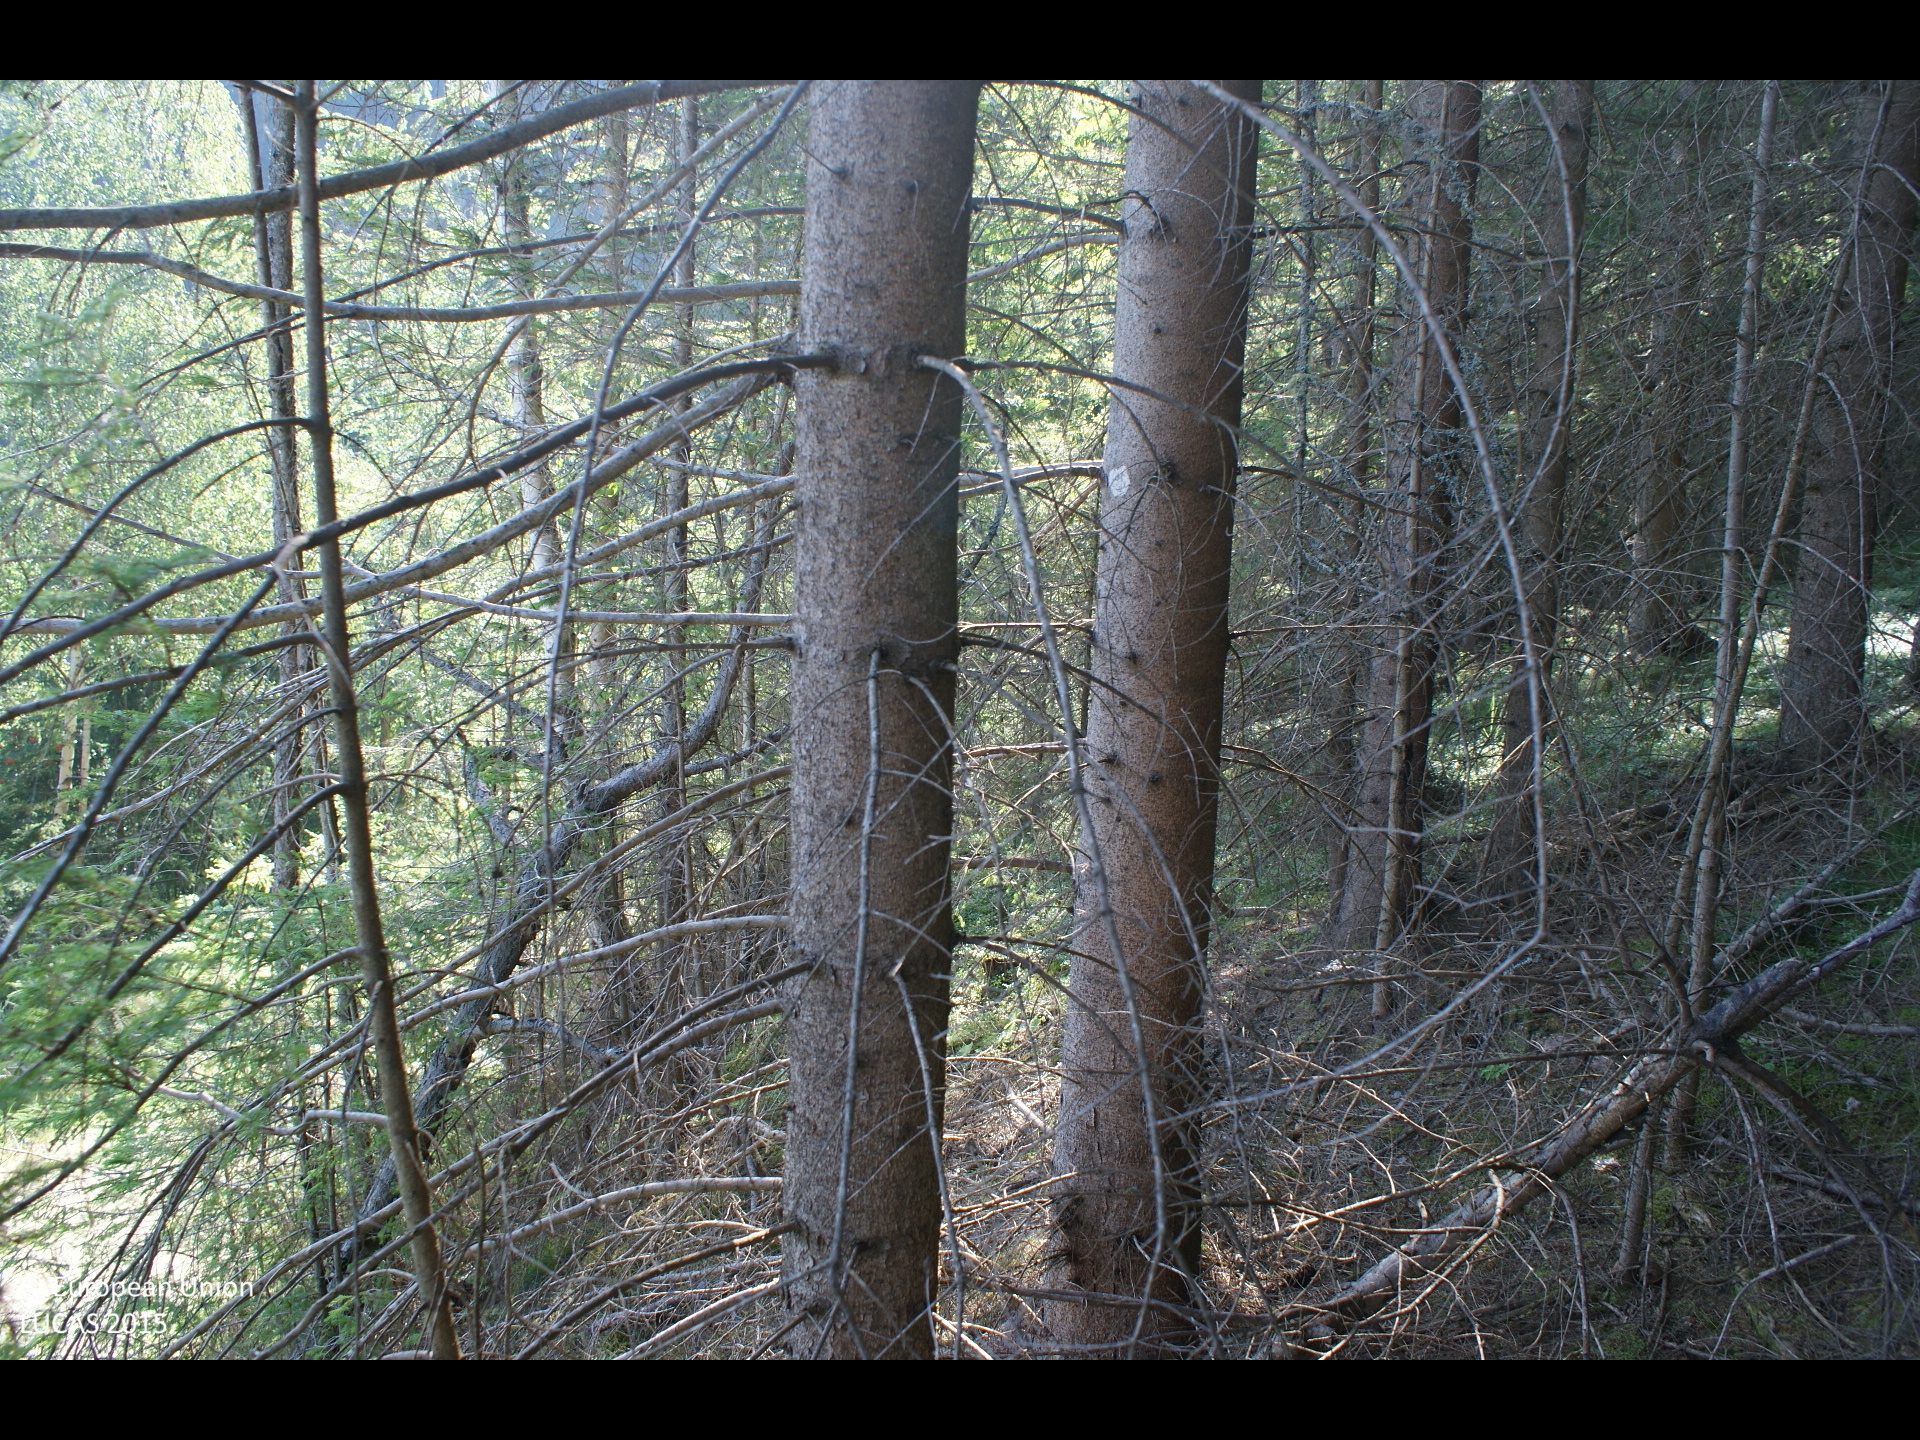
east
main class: Woodland
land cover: Spruce dominated coniferous woodland
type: alpine coniferous forest
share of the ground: > 75 %
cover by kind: coniferous forest trees 85 %, lichens and mosses 10 %, shrubs 5 %
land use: Forestry
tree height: > 5 m
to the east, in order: Spruce dominated coniferous woodland; Tracks; Grass margins; Broadleaved woodland; Tracks; Spruce dominated coniferous woodland; Shrubland with sparse tree cover; Tracks; Spruce dominated coniferous woodland
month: August
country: AT
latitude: 47.5969
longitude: 15.5472
